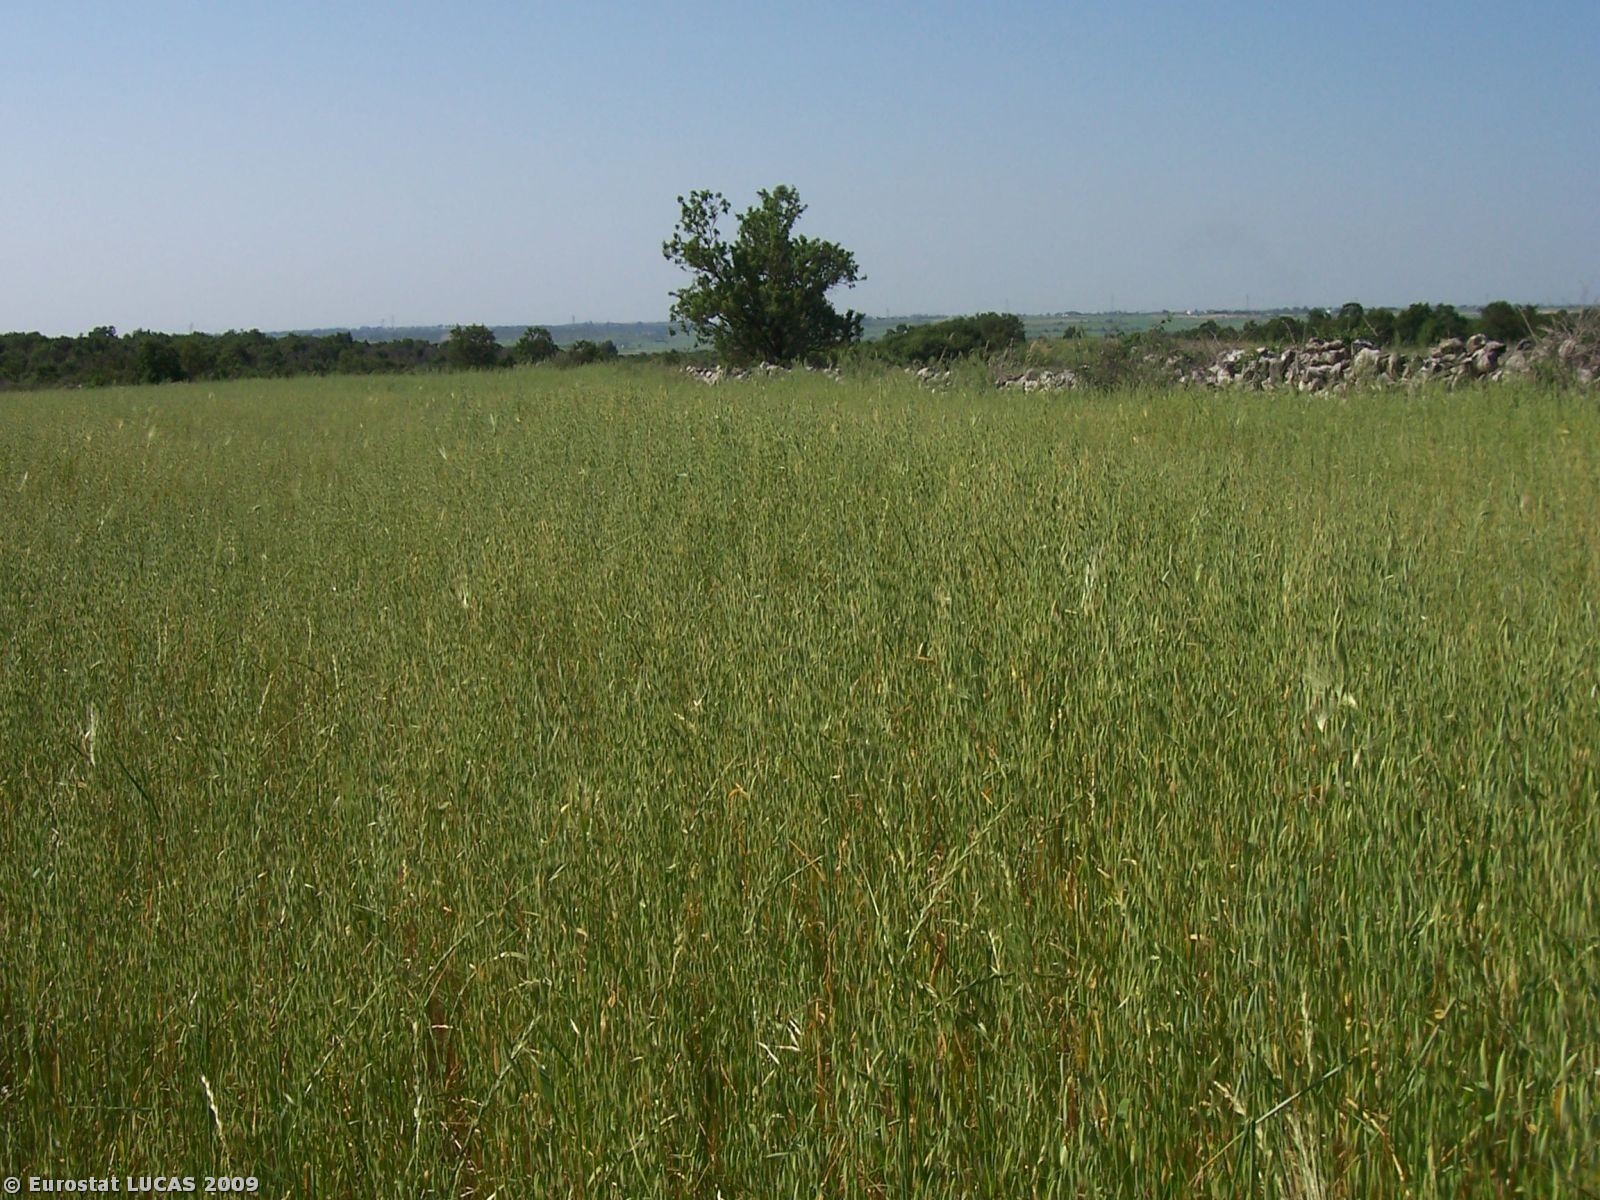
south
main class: Cropland
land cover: Oats
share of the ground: > 75 %
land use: Agriculture (excluding fallow land and kitchen gardens)
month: May
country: IT
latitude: 40.7122
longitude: 16.9254
